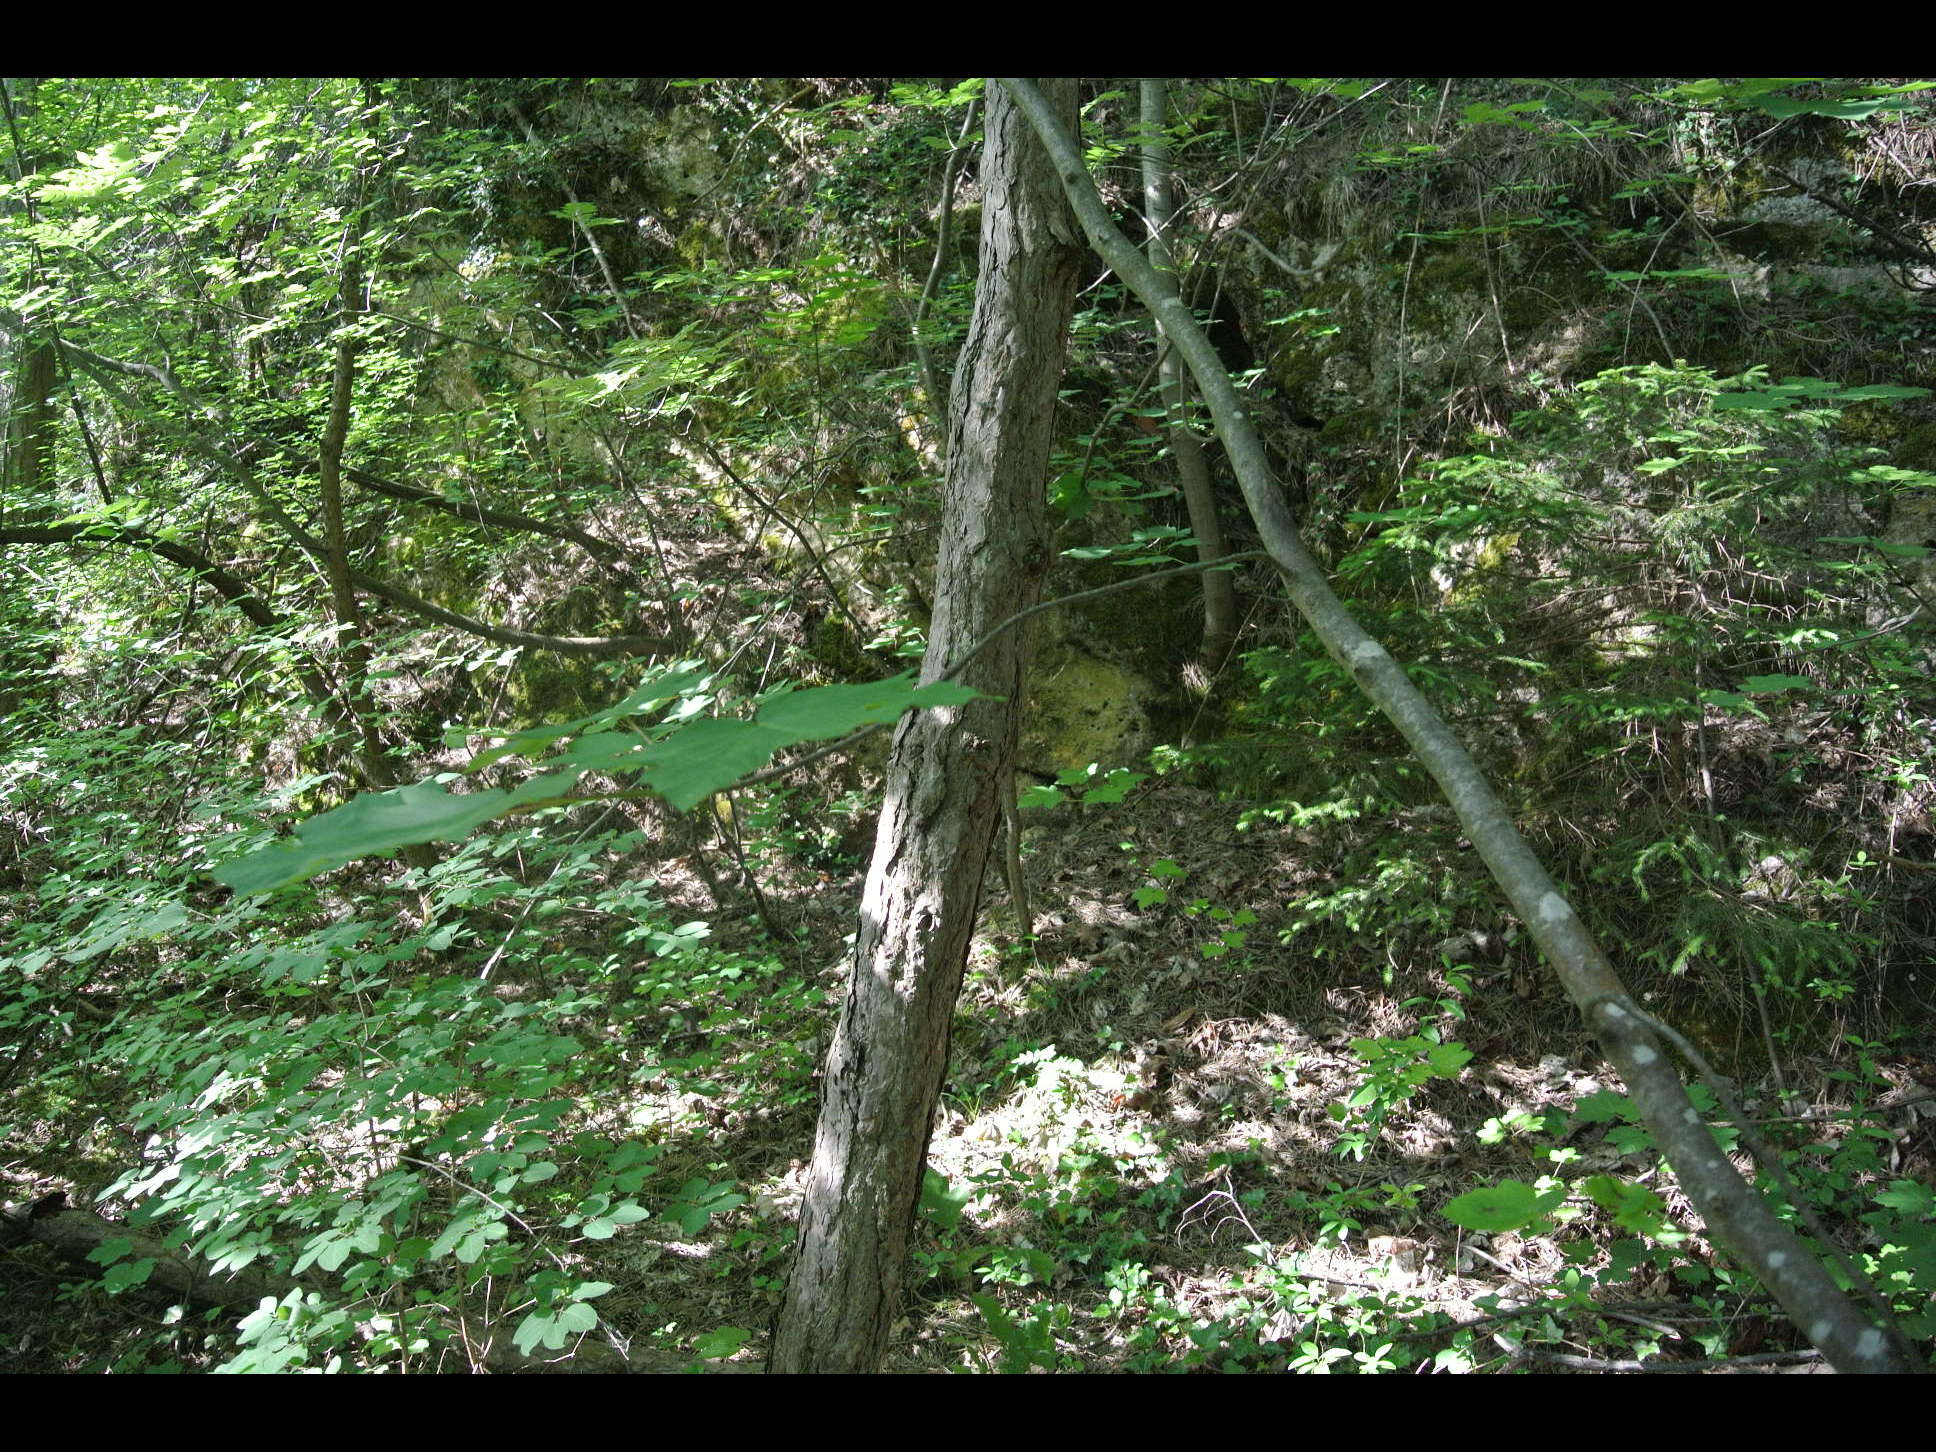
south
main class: Woodland
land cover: Pine dominated mixed woodland
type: alpine coniferous forest
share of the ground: > 75 %
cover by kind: broadleaved forest trees 75 %, coniferous forest trees 25 %
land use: Forestry
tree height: > 5 m
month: May
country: AT
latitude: 47.8346
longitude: 16.1625
